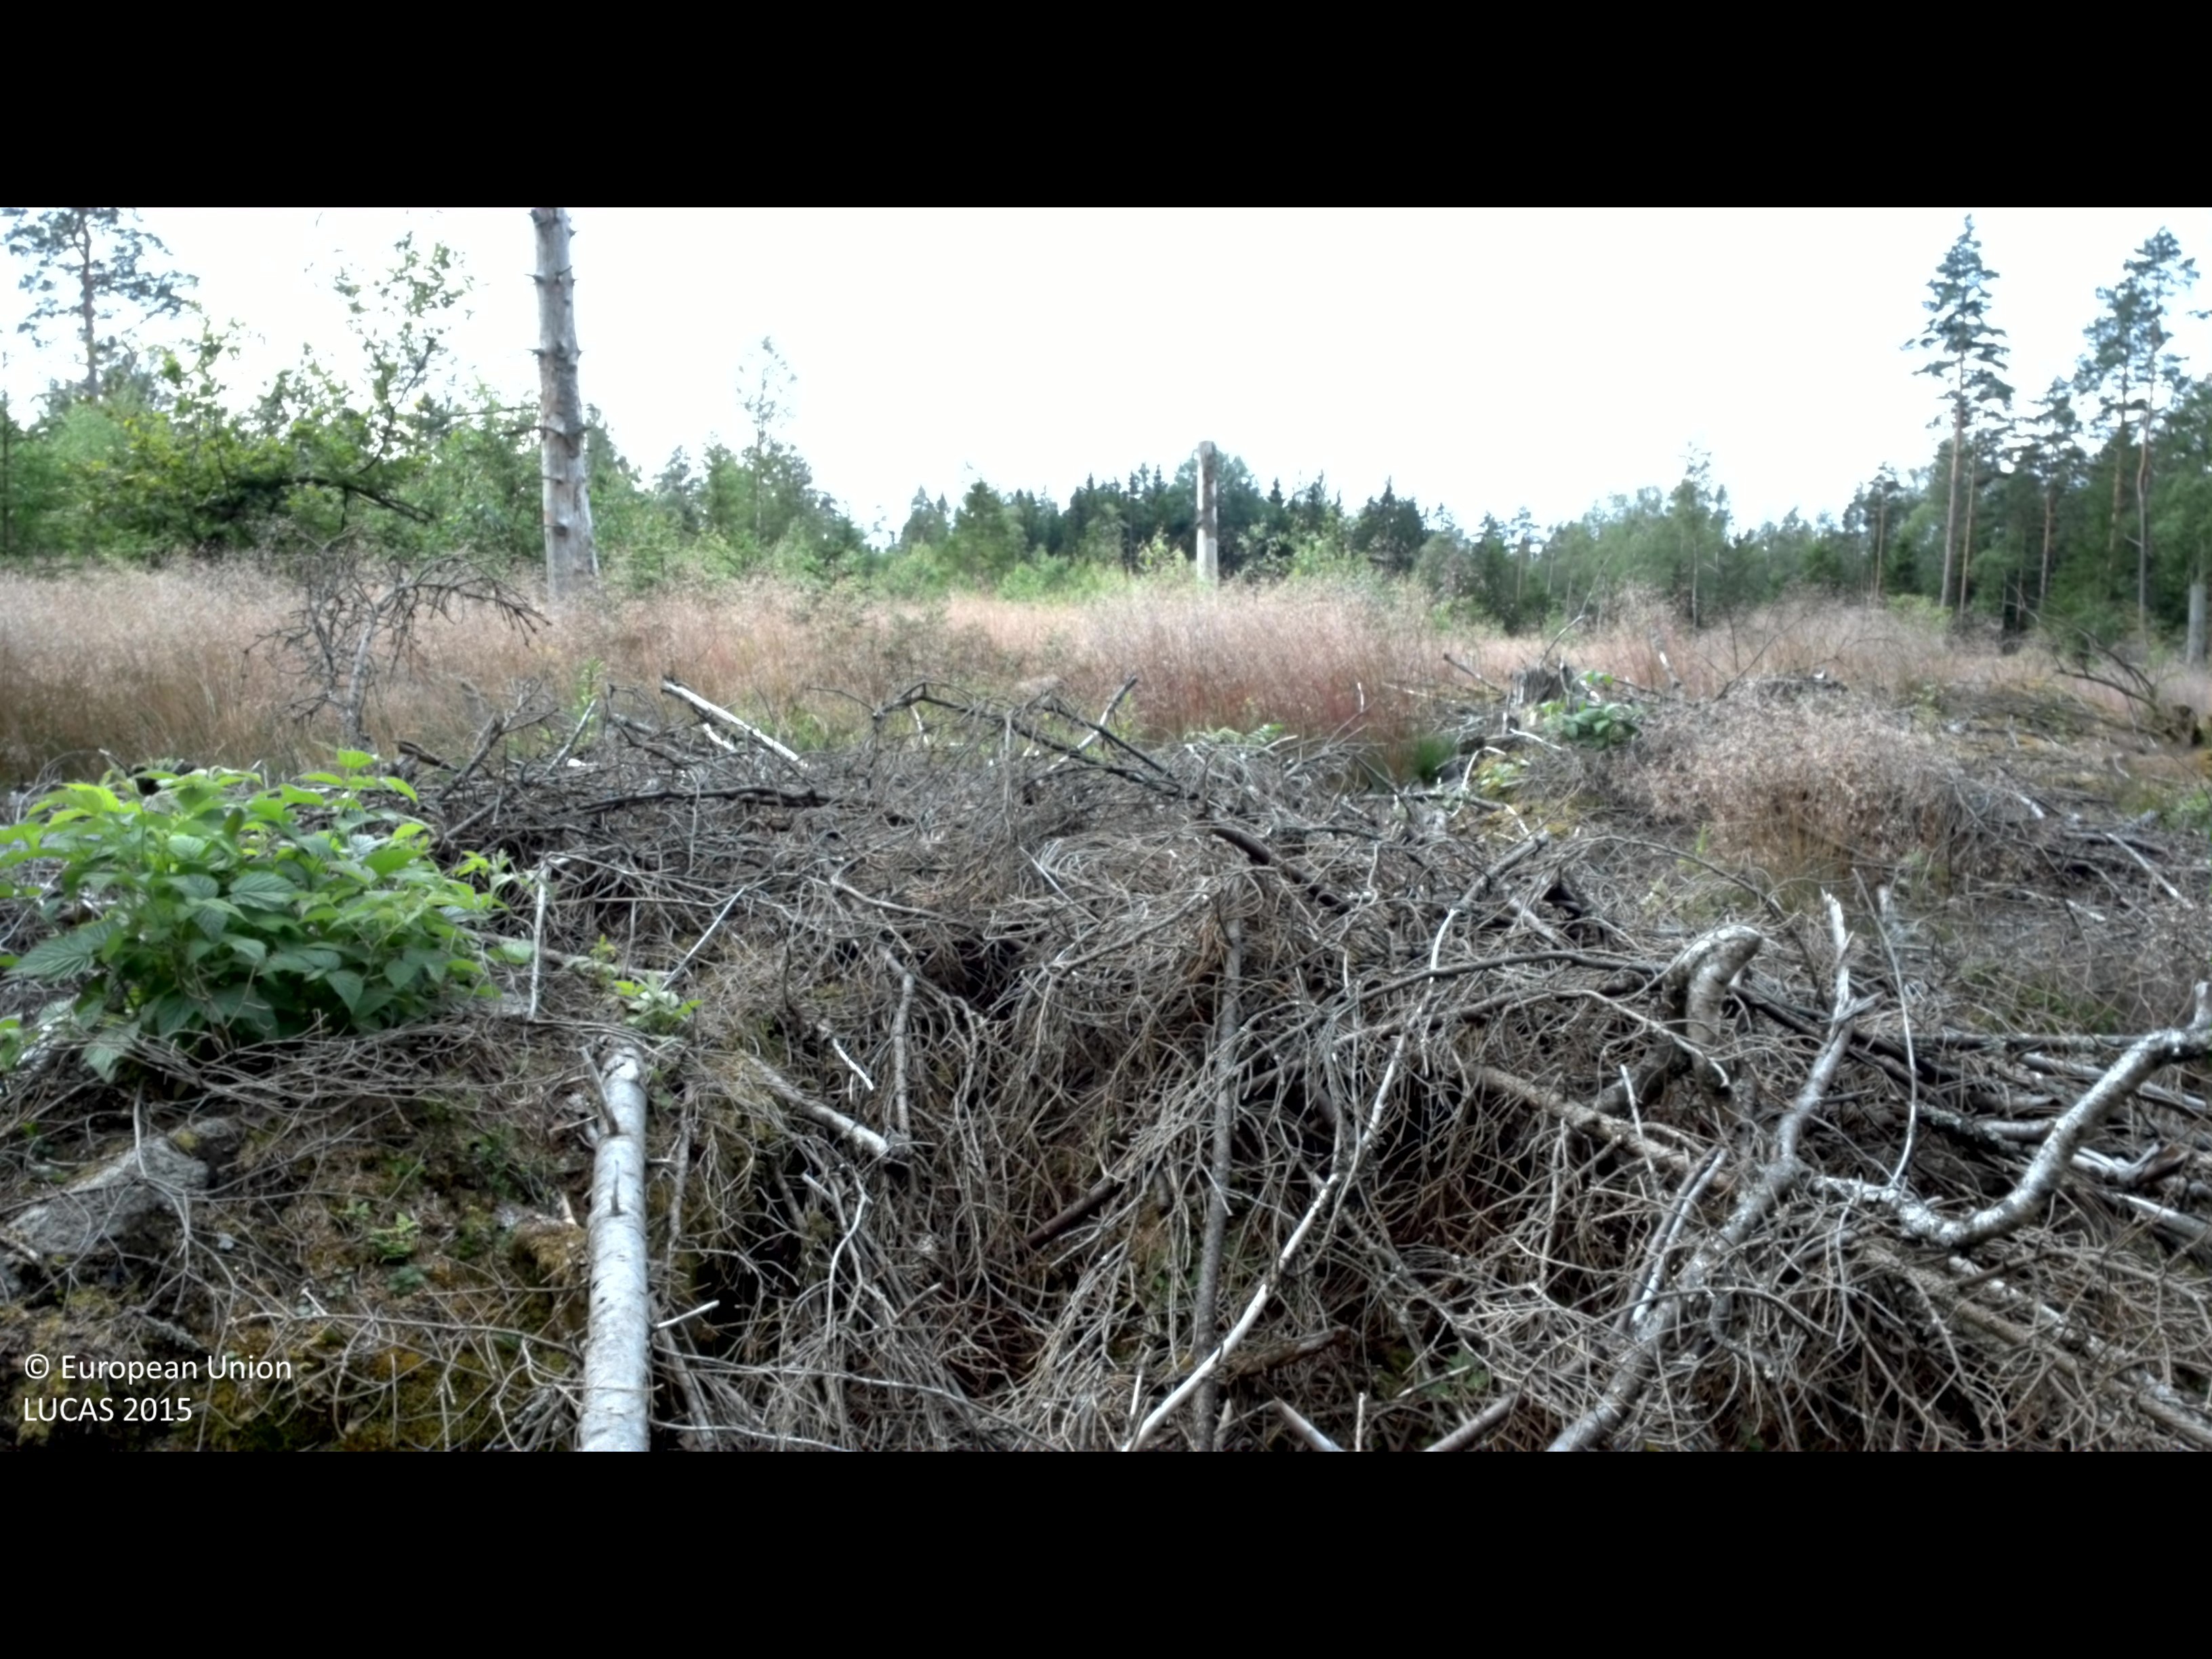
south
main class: Woodland
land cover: Spruce dominated mixed woodland
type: boreal forest
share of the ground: 10 - 25 %
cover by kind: shrubs 20 %, coniferous forest trees 15 %, herbaceous plants 15 %, unconsolidated bare surface 10 %, broadleaved forest trees 5 %, lichens and mosses 5 %
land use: Forestry
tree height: > 5 m
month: July
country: SE
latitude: 56.4453
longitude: 14.1339
